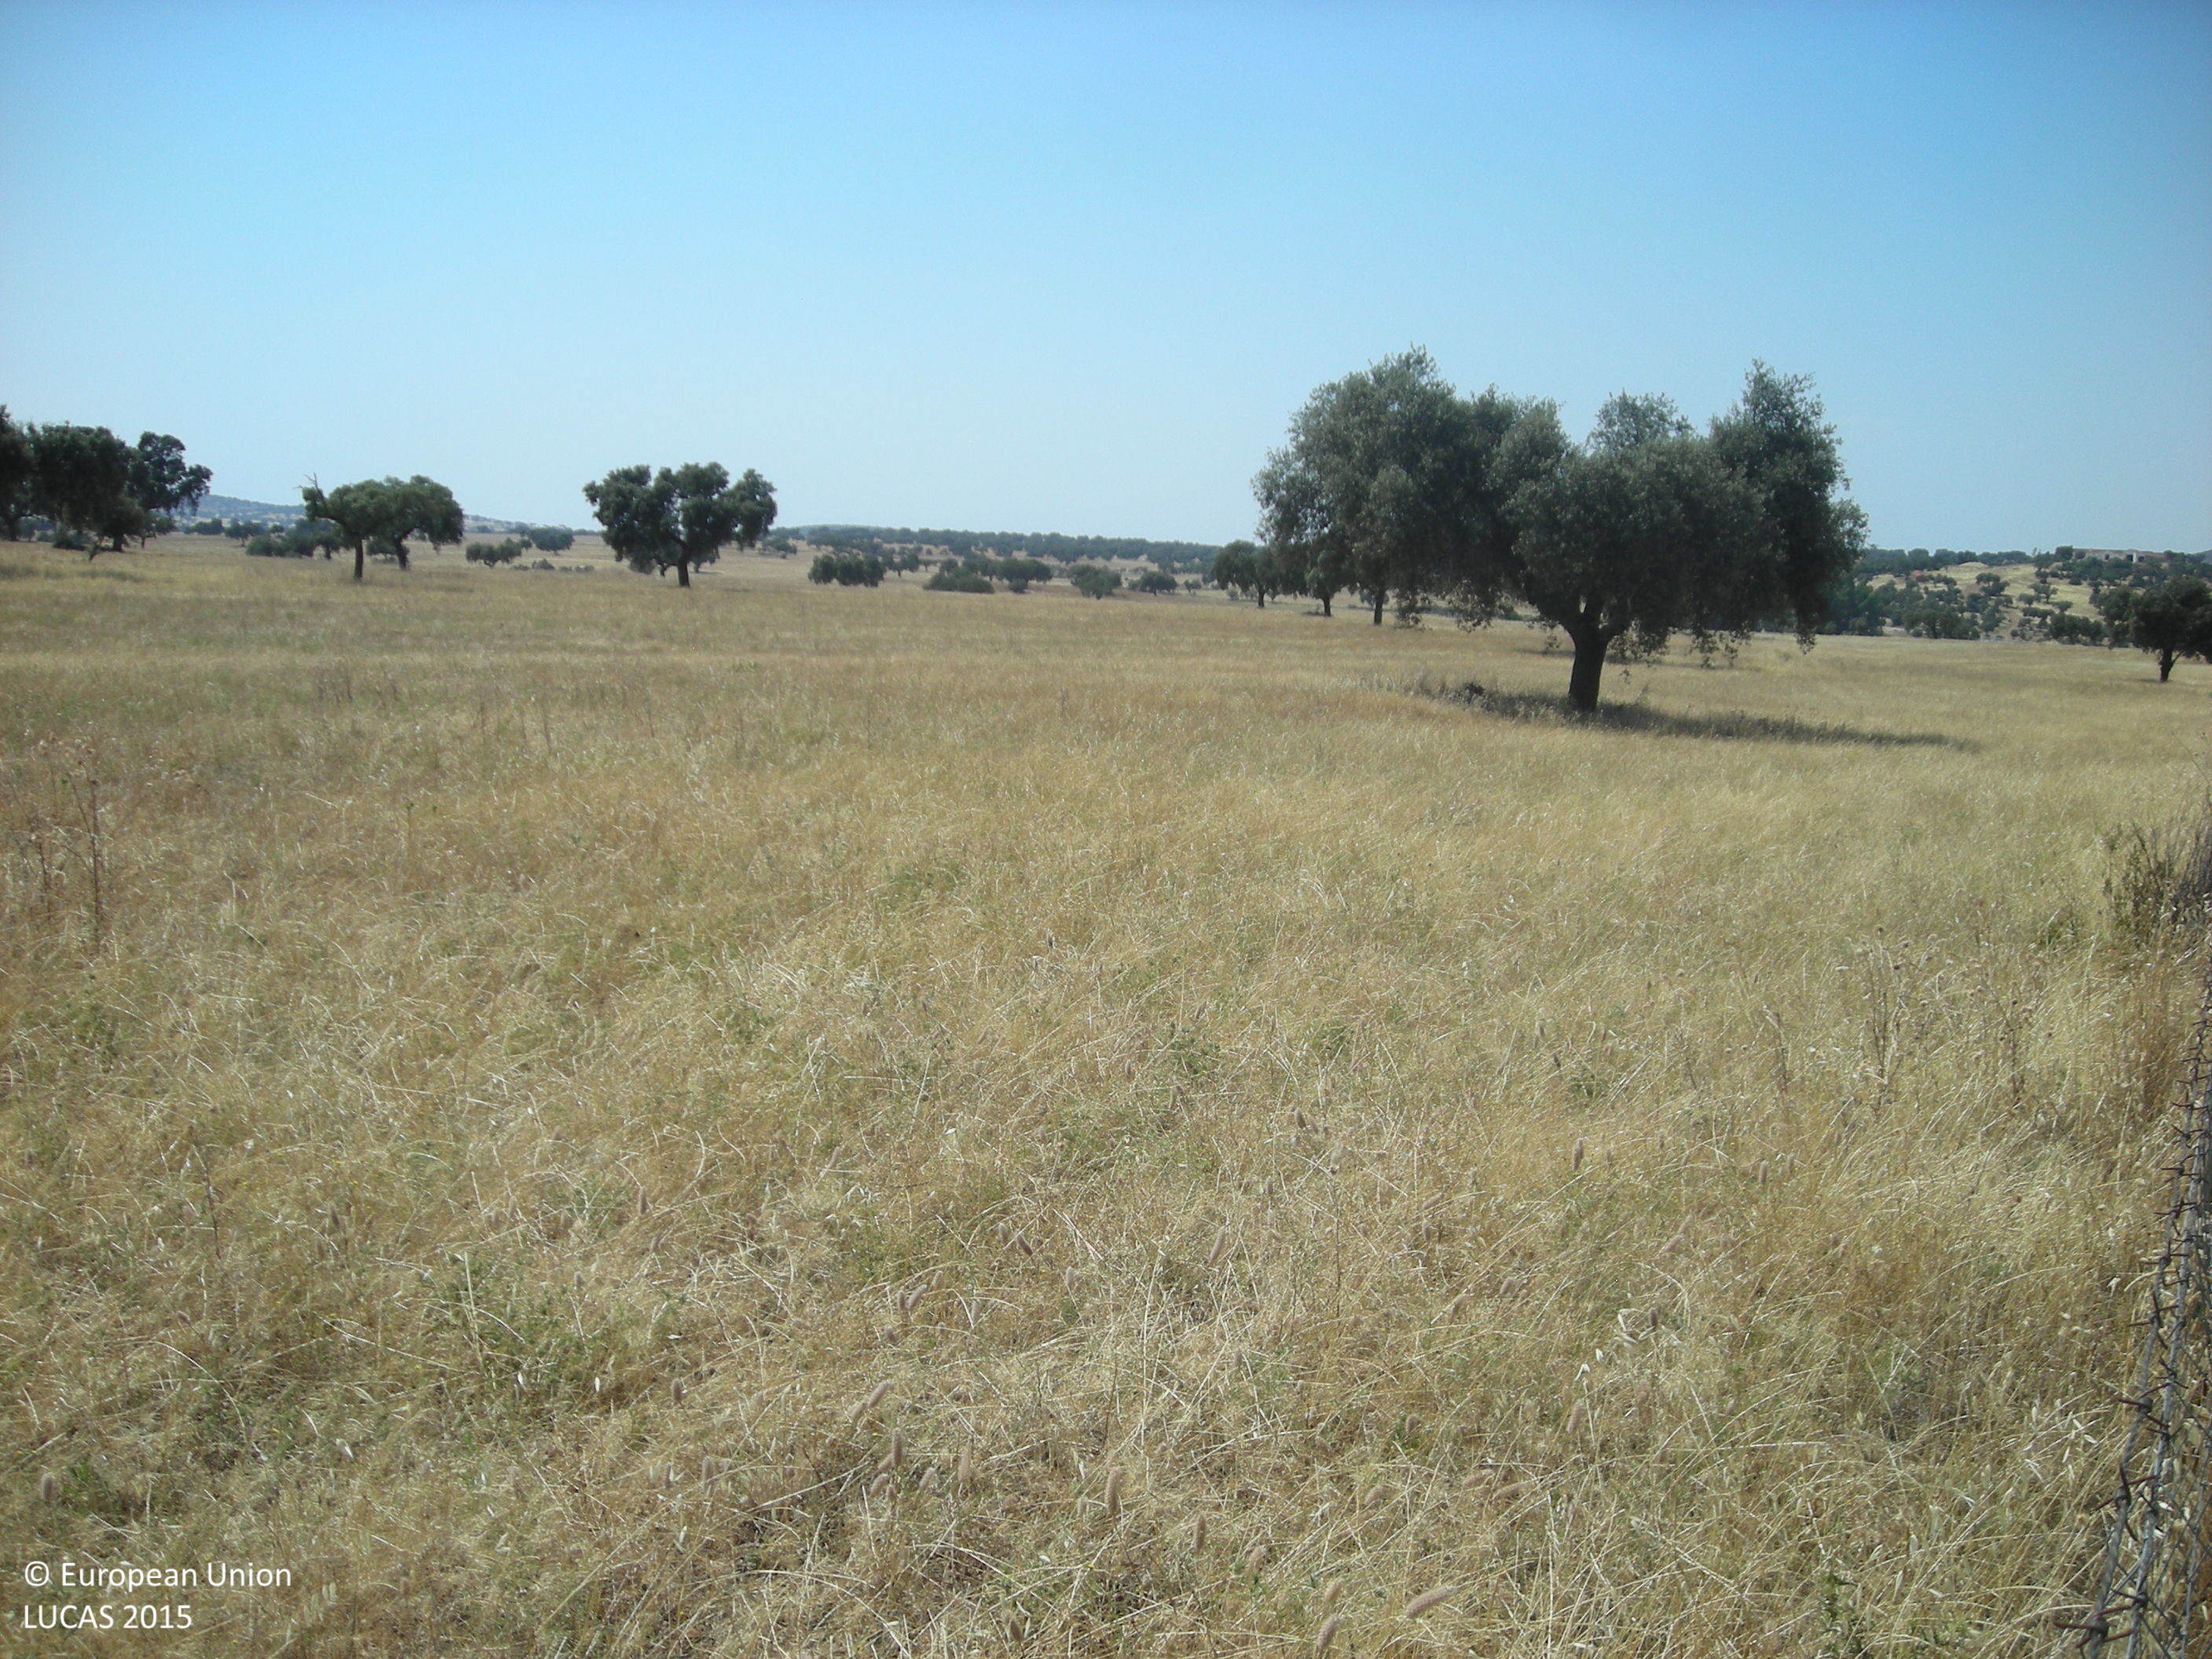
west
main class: Grassland
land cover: Grassland without tree/shrub cover
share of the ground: > 75 %
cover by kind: herbaceous plants 100 %
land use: Agriculture (excluding fallow land and kitchen gardens)
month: June
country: ES
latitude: 38.6148
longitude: -5.8812
